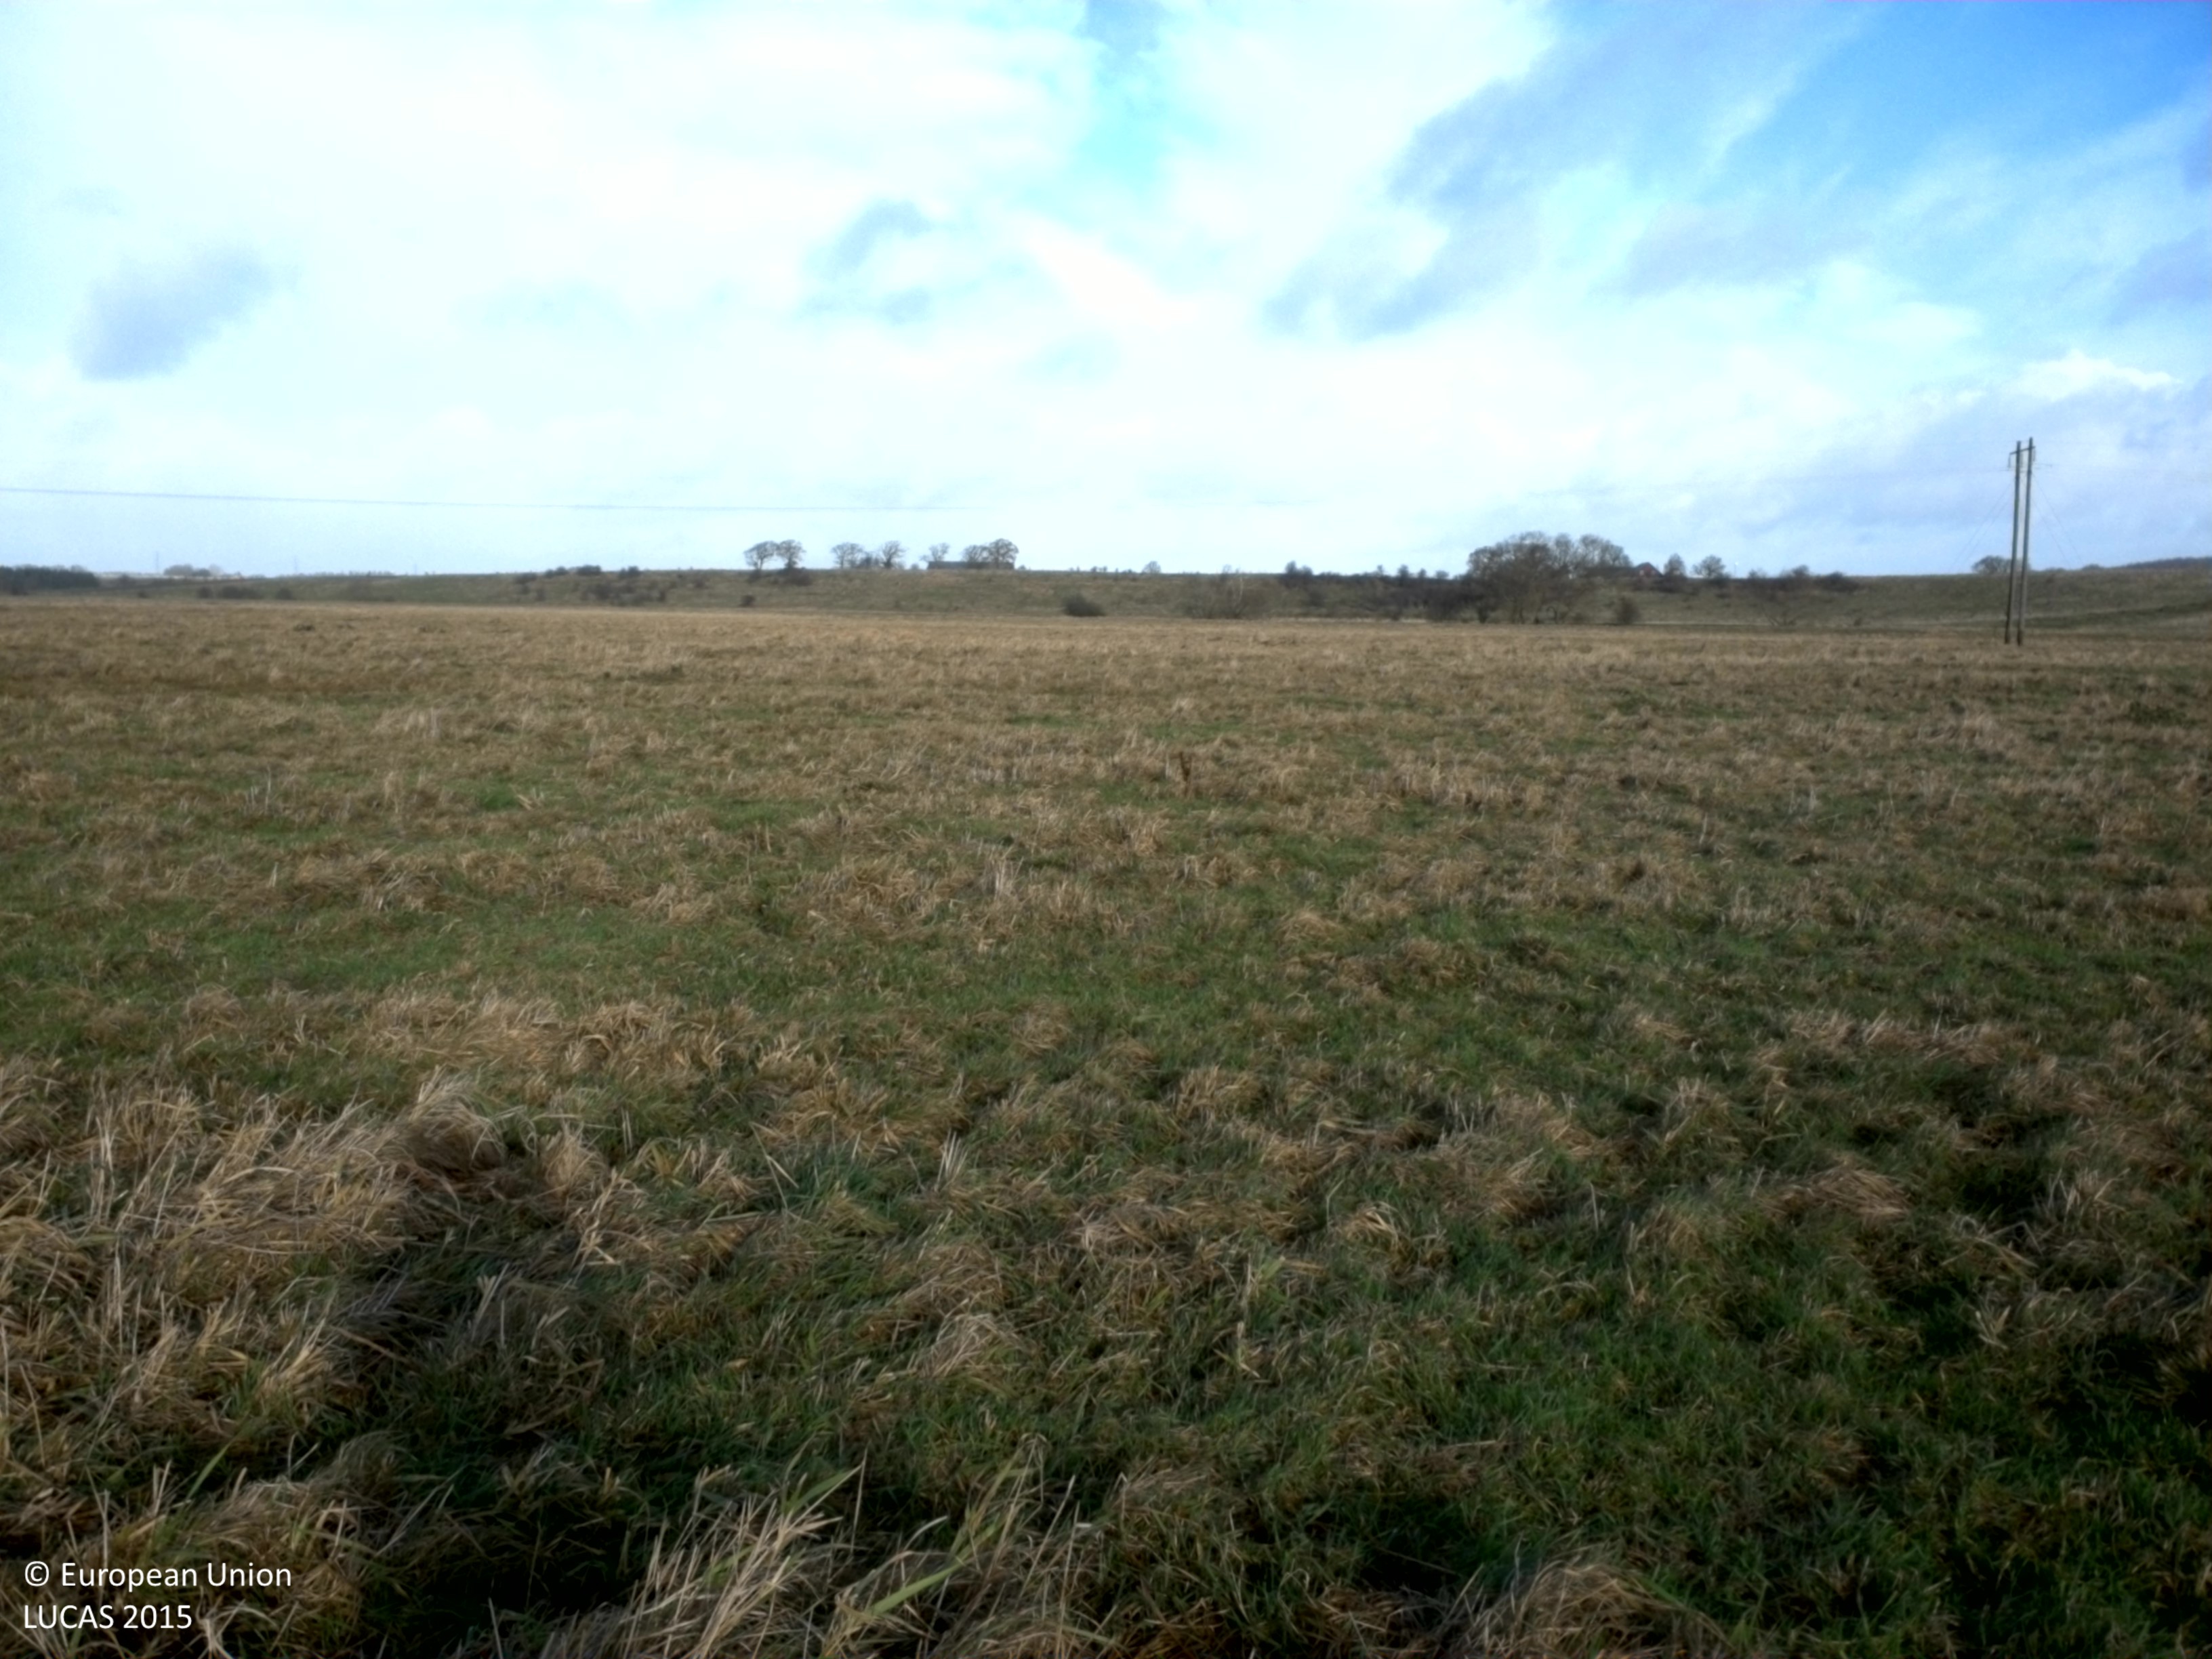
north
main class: Grassland
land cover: Grassland without tree/shrub cover
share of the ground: > 75 %
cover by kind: herbaceous plants 100 %
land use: Agriculture (excluding fallow land and kitchen gardens)
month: November
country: SE
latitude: 56.1510
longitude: 13.0721
